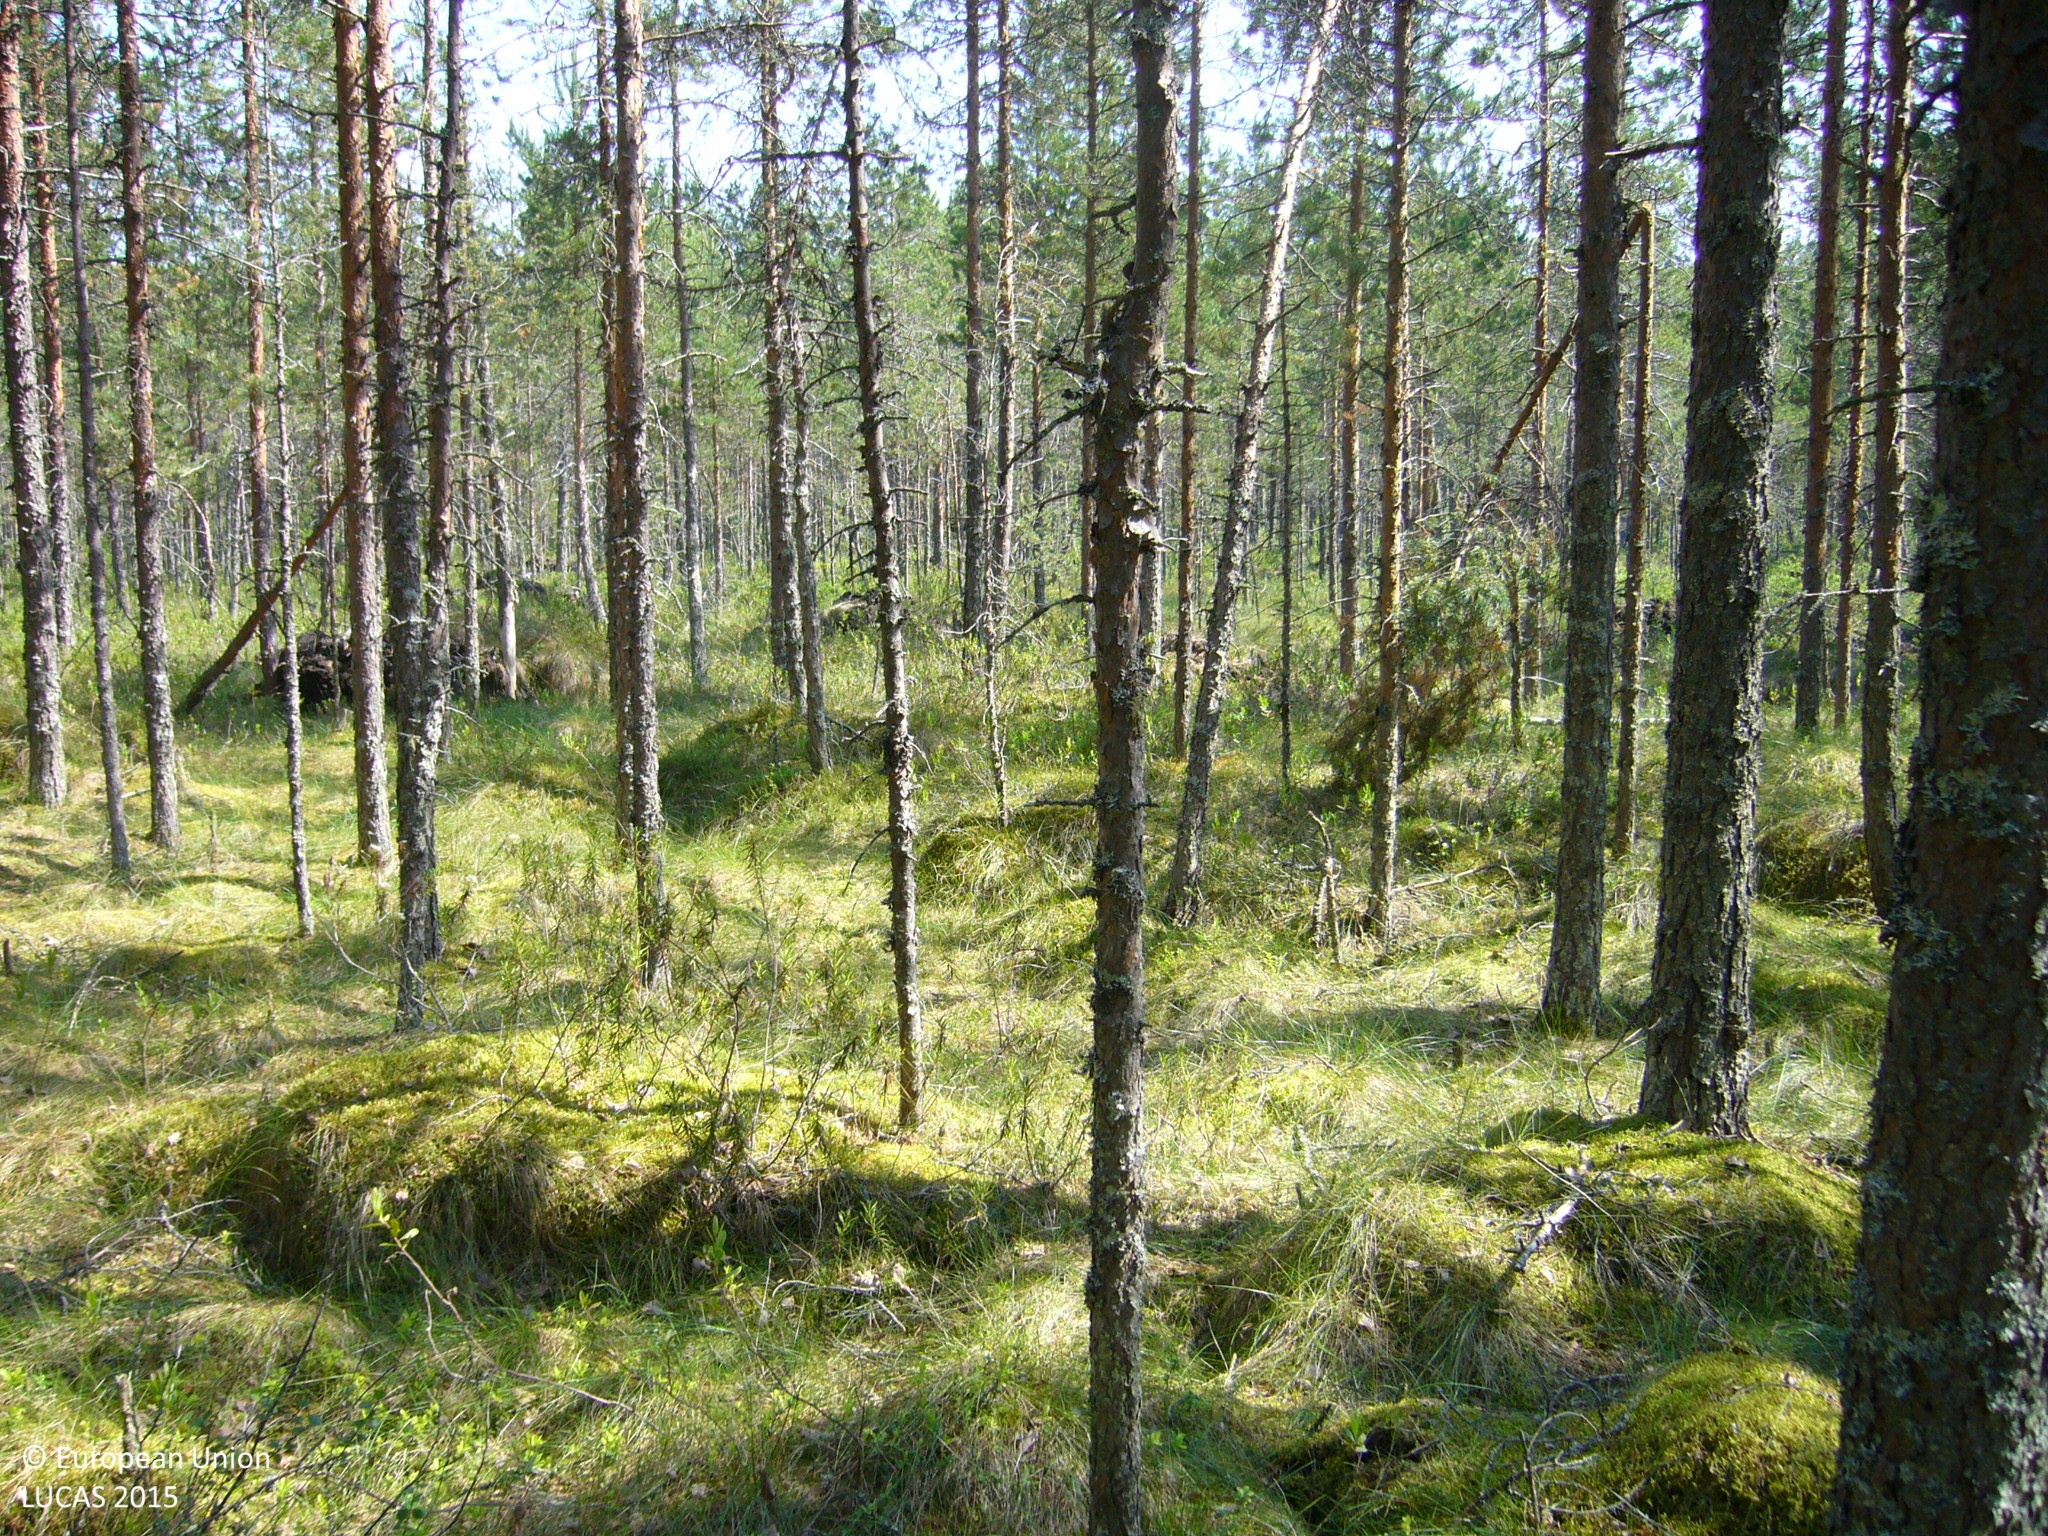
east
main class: Woodland
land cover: Pine dominated coniferous woodland
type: boreal forest
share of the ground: > 75 %
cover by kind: coniferous forest trees 70 %, shrubs 20 %, broadleaved forest trees 10 %
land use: Forestry
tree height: > 5 m
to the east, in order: Pine dominated coniferous woodland; Ditches and canals; Pine dominated coniferous woodland; Ditches and canals; Pine dominated coniferous woodland; Ditches and canals; Pine dominated coniferous woodland; Ditches and canals; Pine dominated coniferous woodland; Ditches and canals; Pine dominated coniferous woodland; Ditches and canals; Pine dominated coniferous woodland; Ditches and canals; Pine dominated mixed woodland; Ditches and canals; Pine dominated mixed woodland; Ditches and canals; Pine dominated mixed woodland; Ditches and canals; Pine dominated mixed woodland
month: July
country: FI
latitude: 63.5765
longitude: 25.8393
